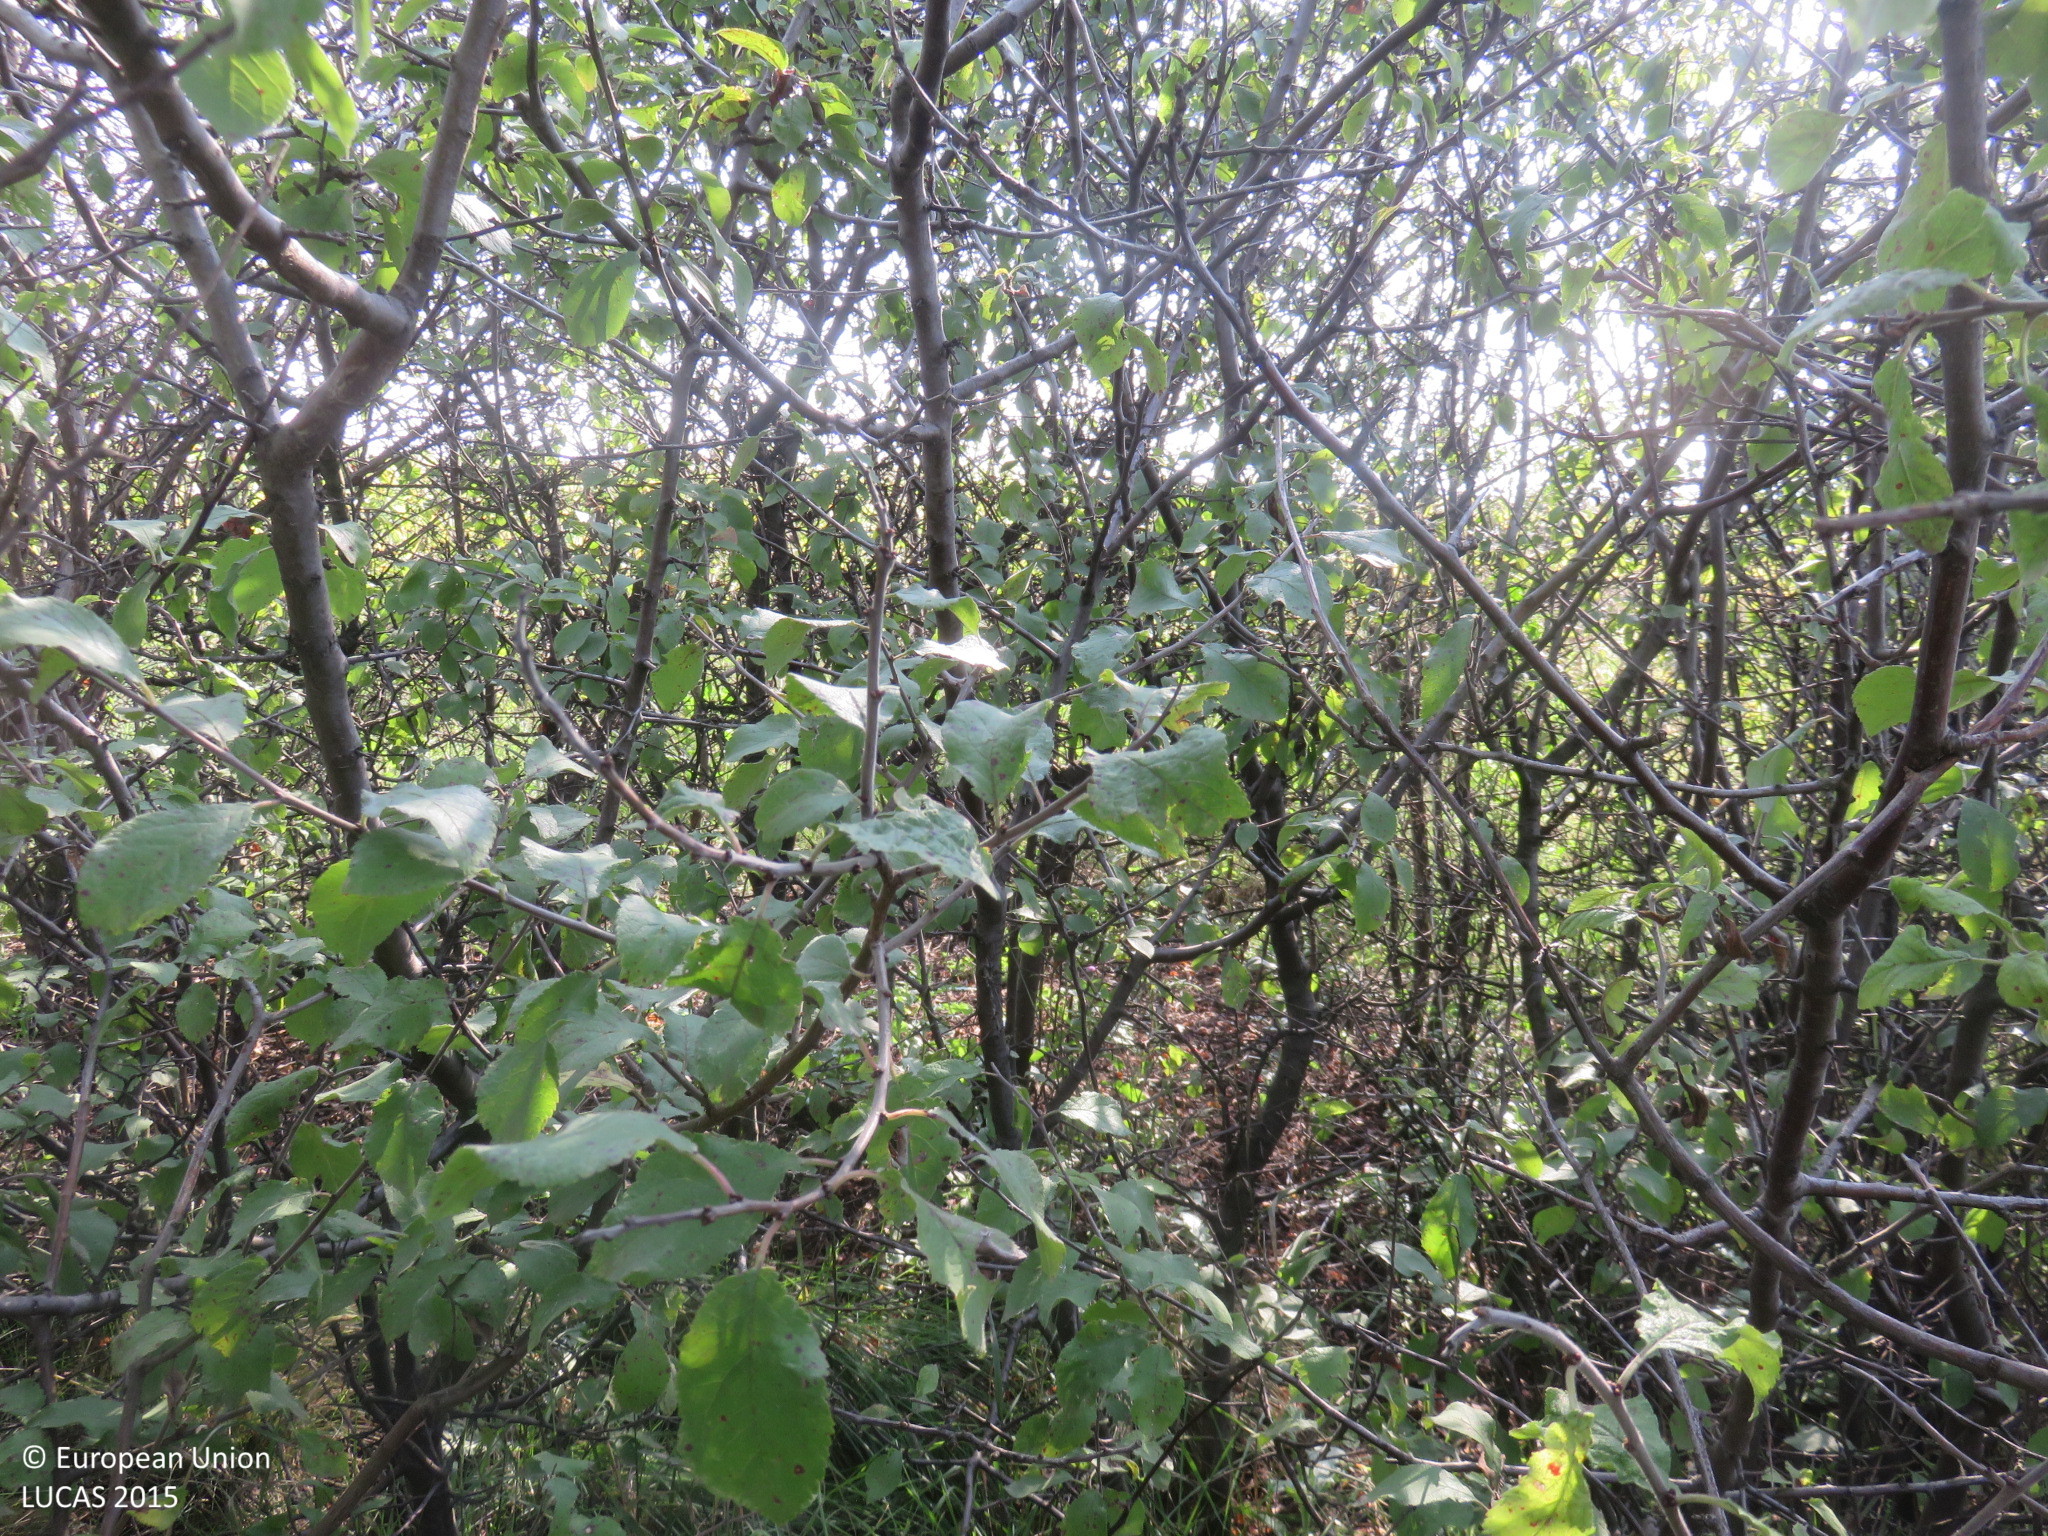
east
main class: Shrubland
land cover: Shrubland with sparse tree cover
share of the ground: > 75 %
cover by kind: shrubs 95 %, broadleaved forest trees 5 %
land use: Semi-natural and natural areas not in use
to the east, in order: Shrubland with sparse tree cover; Grass margins; Sunflower
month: September
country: BG
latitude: 43.1633
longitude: 24.9865
